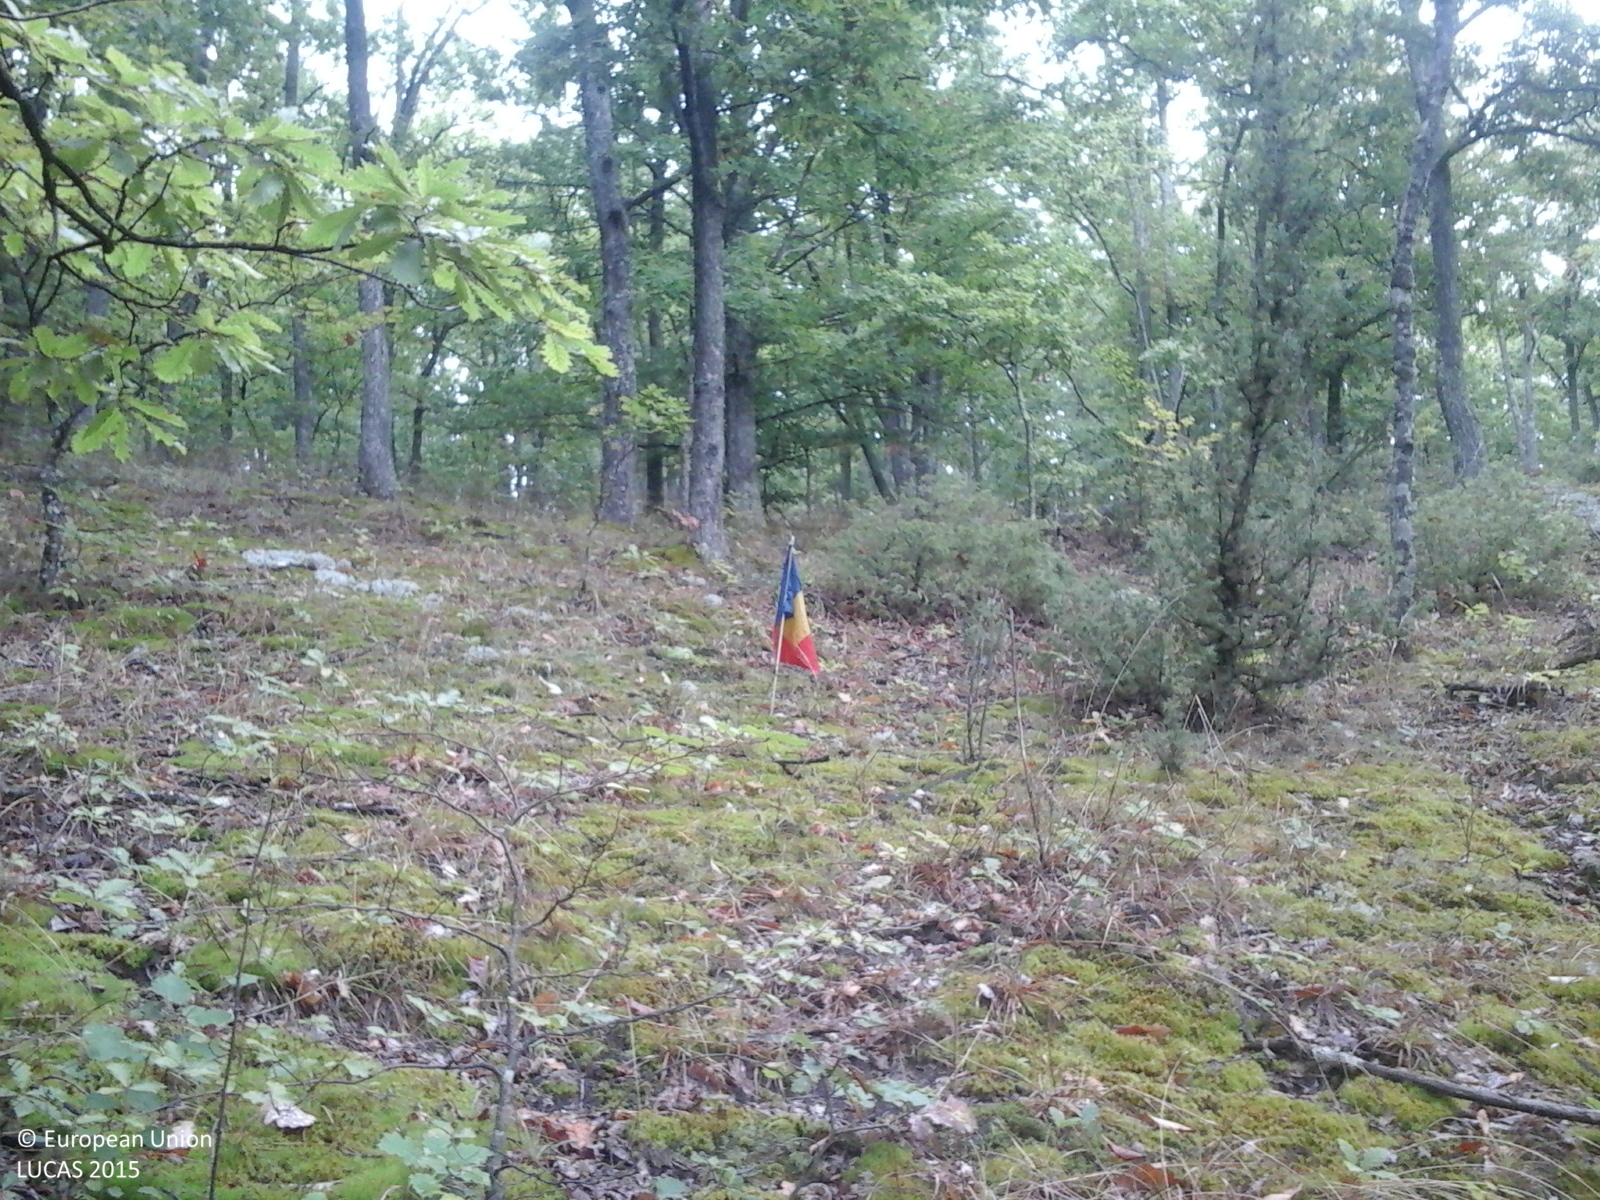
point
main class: Woodland
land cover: Broadleaved woodland
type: acidophilous oak and oak-birch forest
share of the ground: > 75 %
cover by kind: broadleaved forest trees 100 %
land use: Forestry
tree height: > 5 m
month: September
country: RO
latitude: 45.7393
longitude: 22.2139
